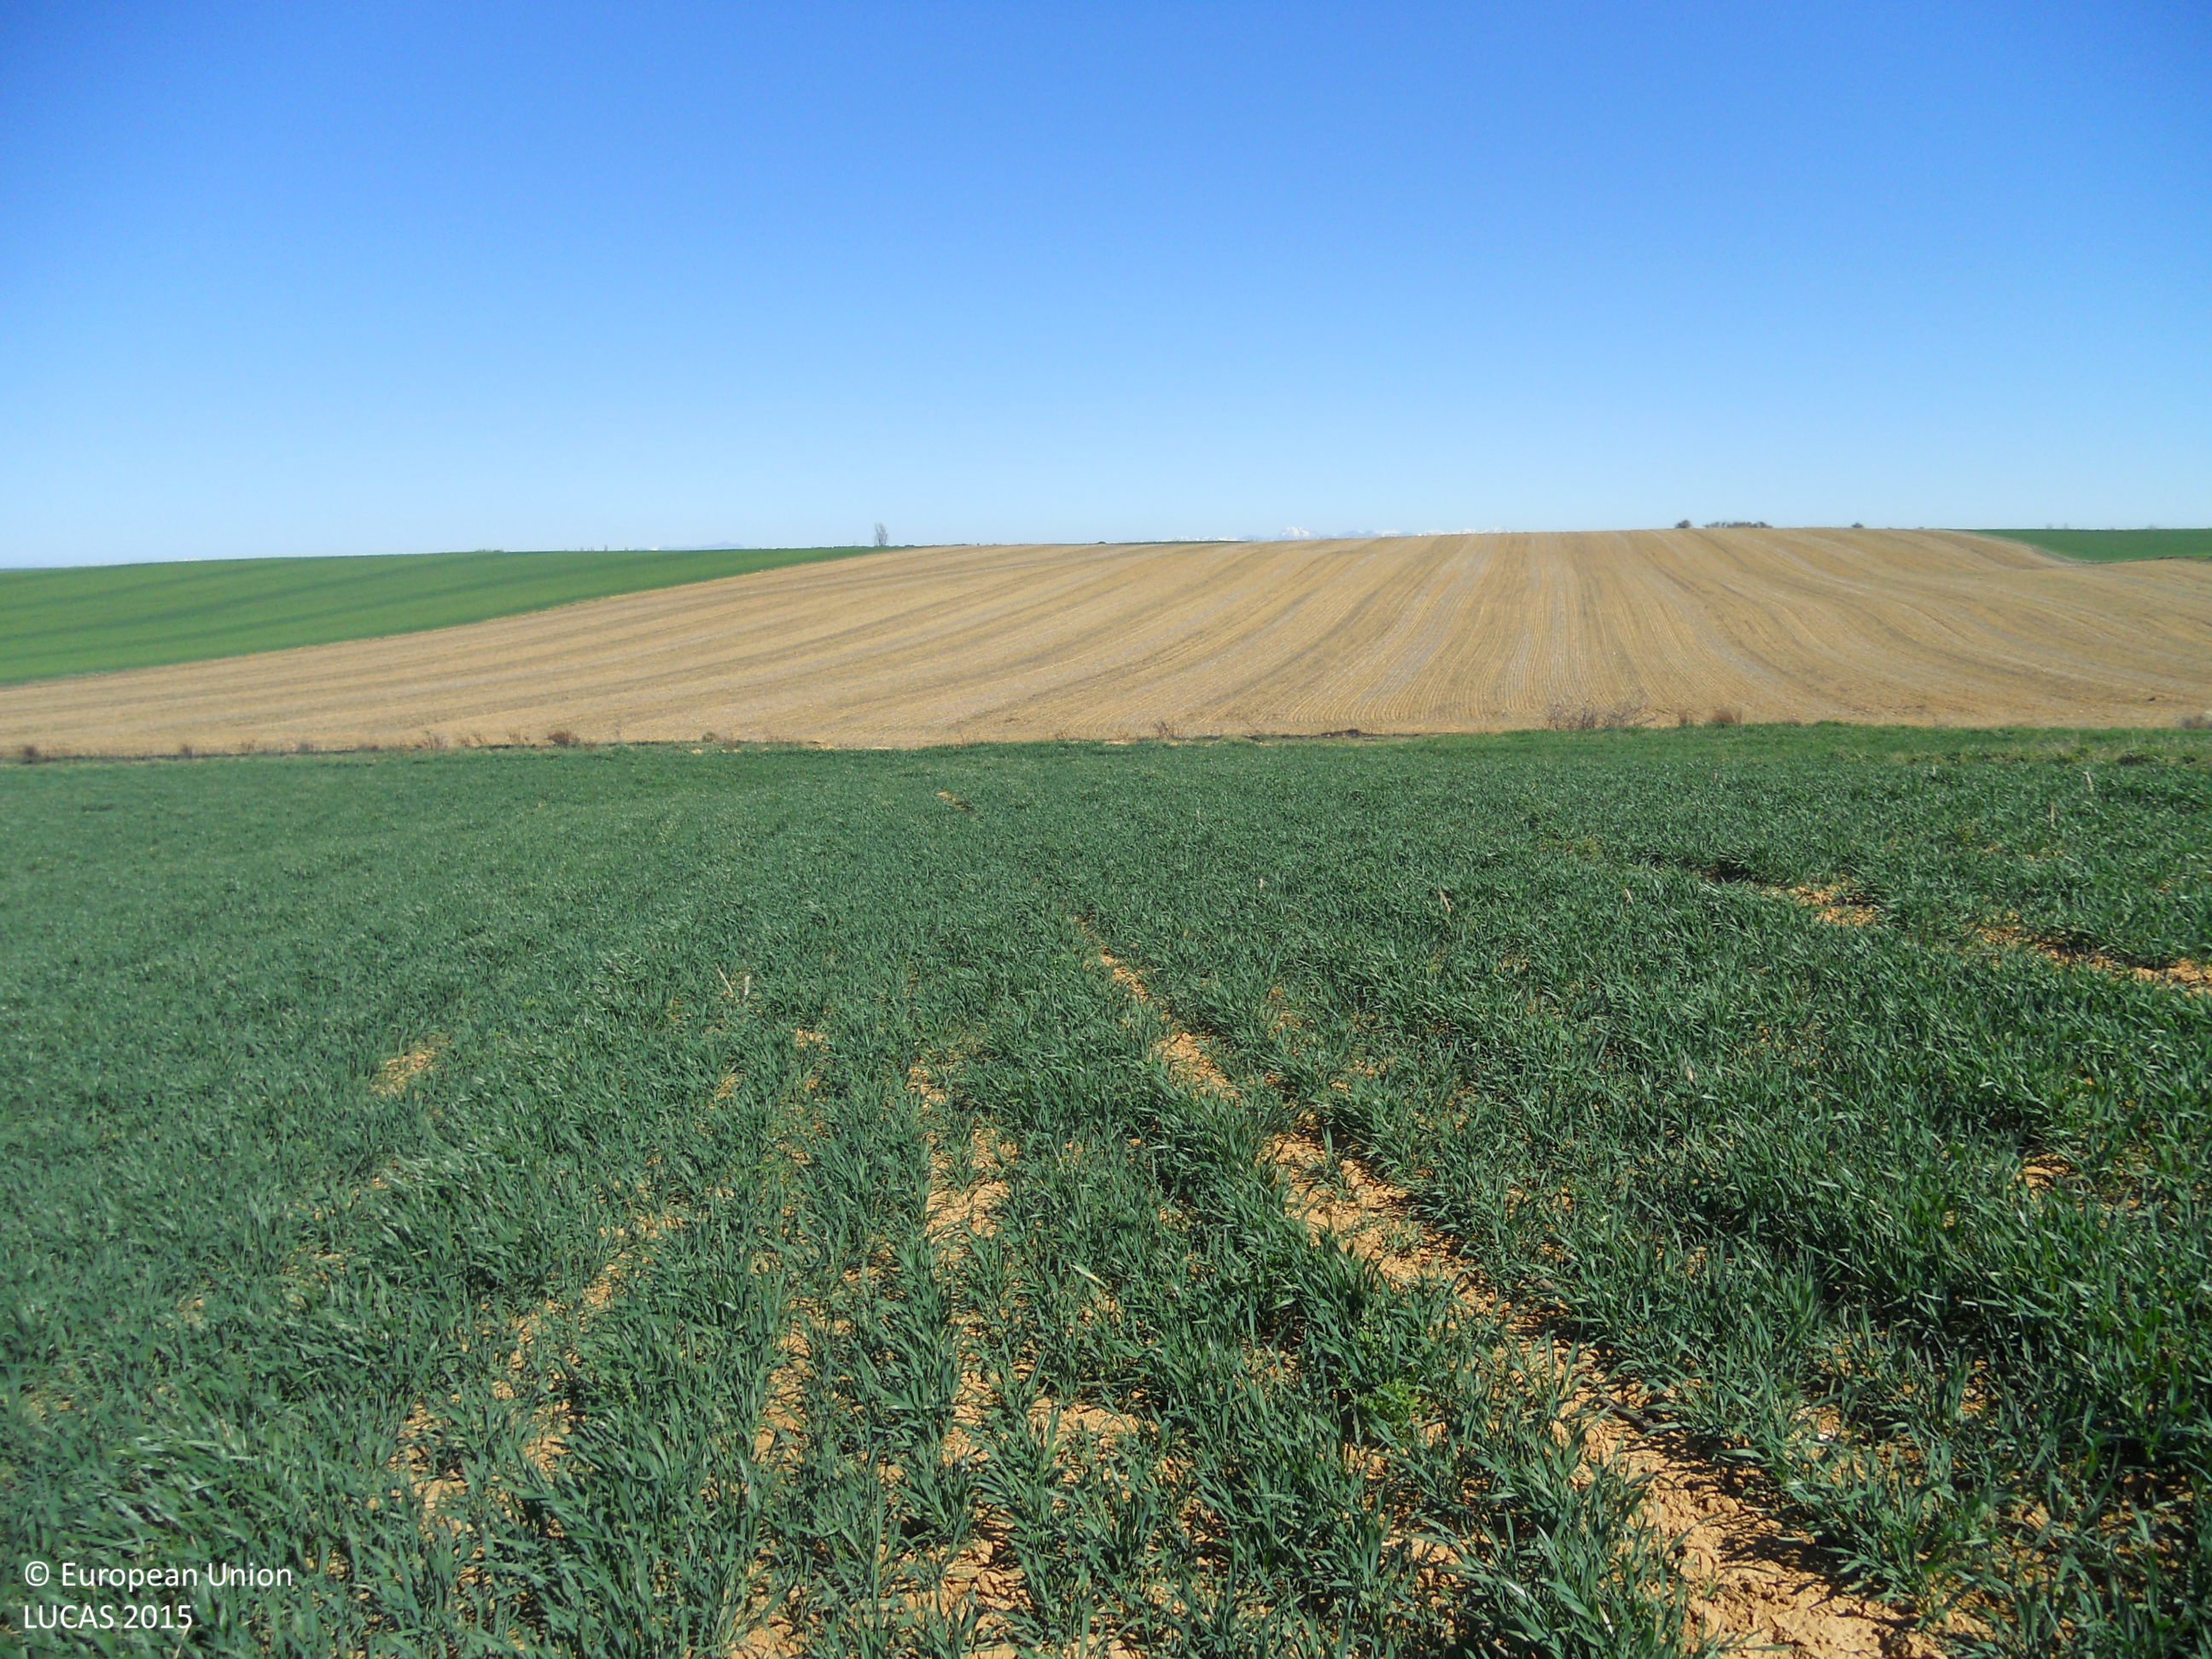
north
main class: Cropland
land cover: Common wheat
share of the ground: > 75 %
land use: Agriculture (excluding fallow land and kitchen gardens)
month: April
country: ES
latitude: 42.2520
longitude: -4.8293
